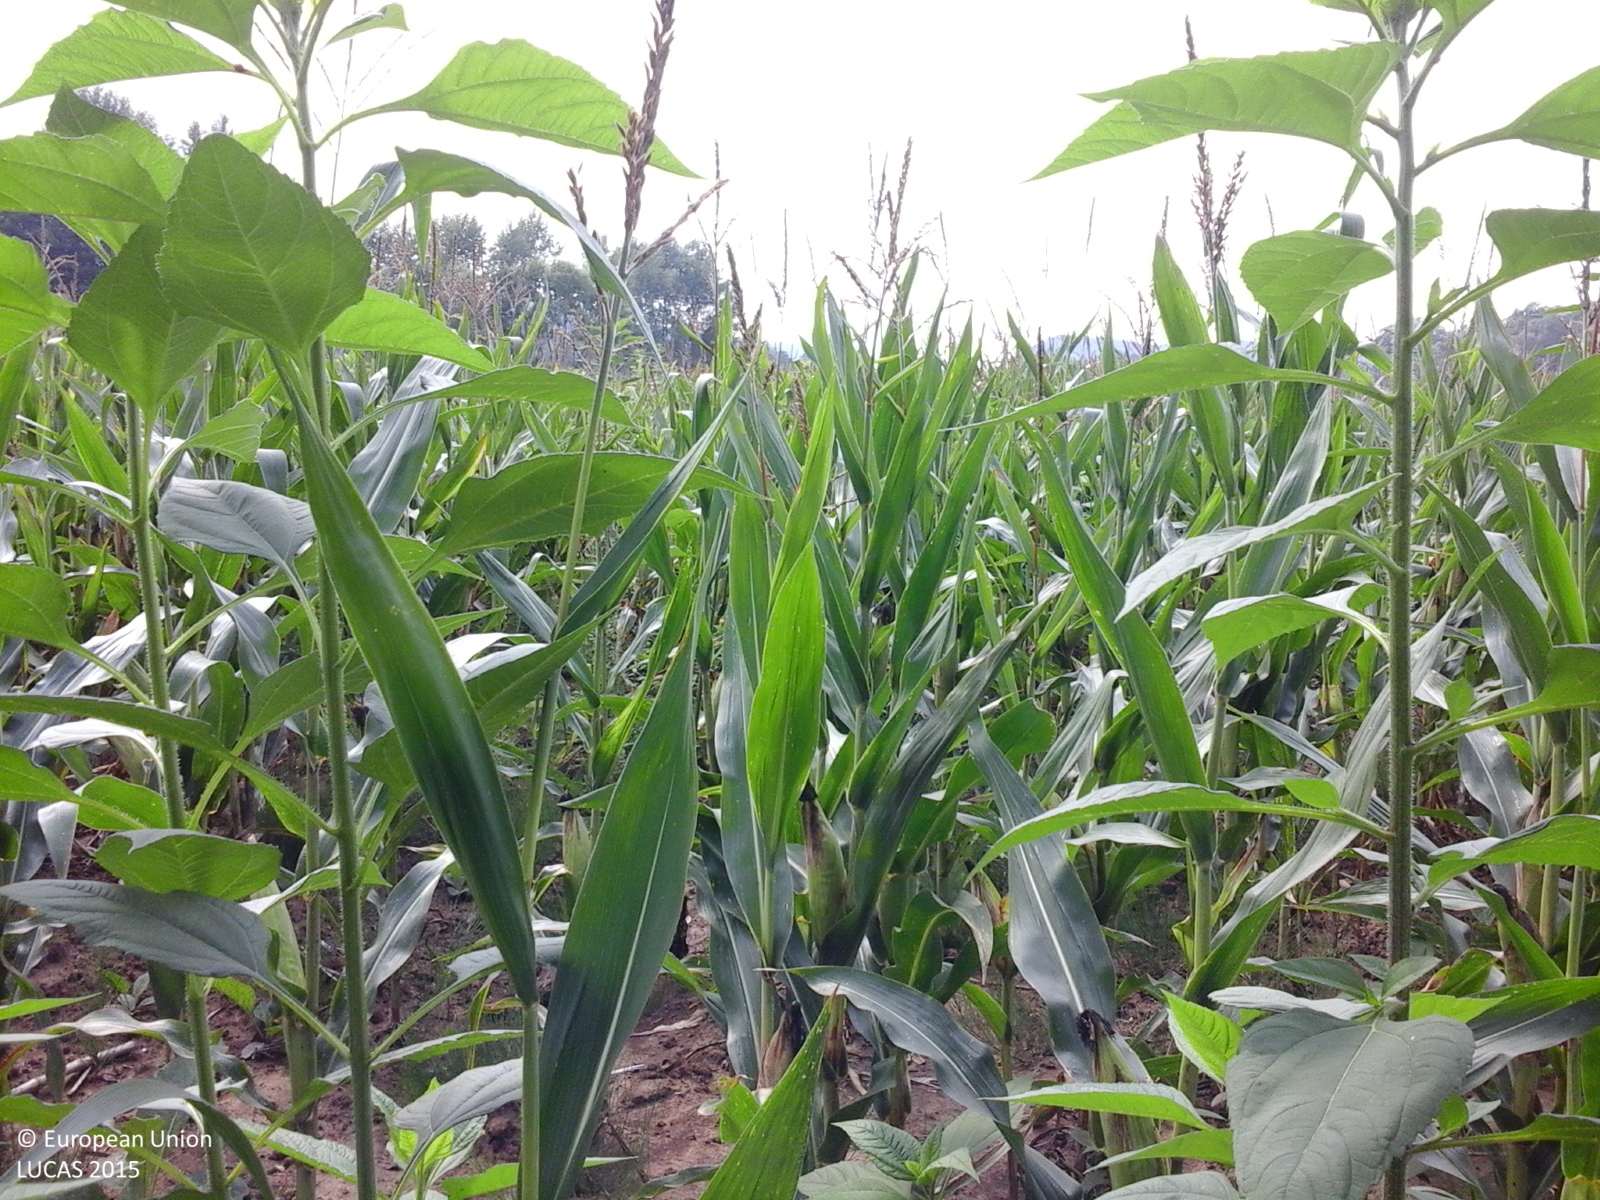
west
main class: Cropland
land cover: Maize
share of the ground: > 75 %
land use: Agriculture (excluding fallow land and kitchen gardens)
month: August
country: RO
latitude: 46.3040
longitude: 22.2119
